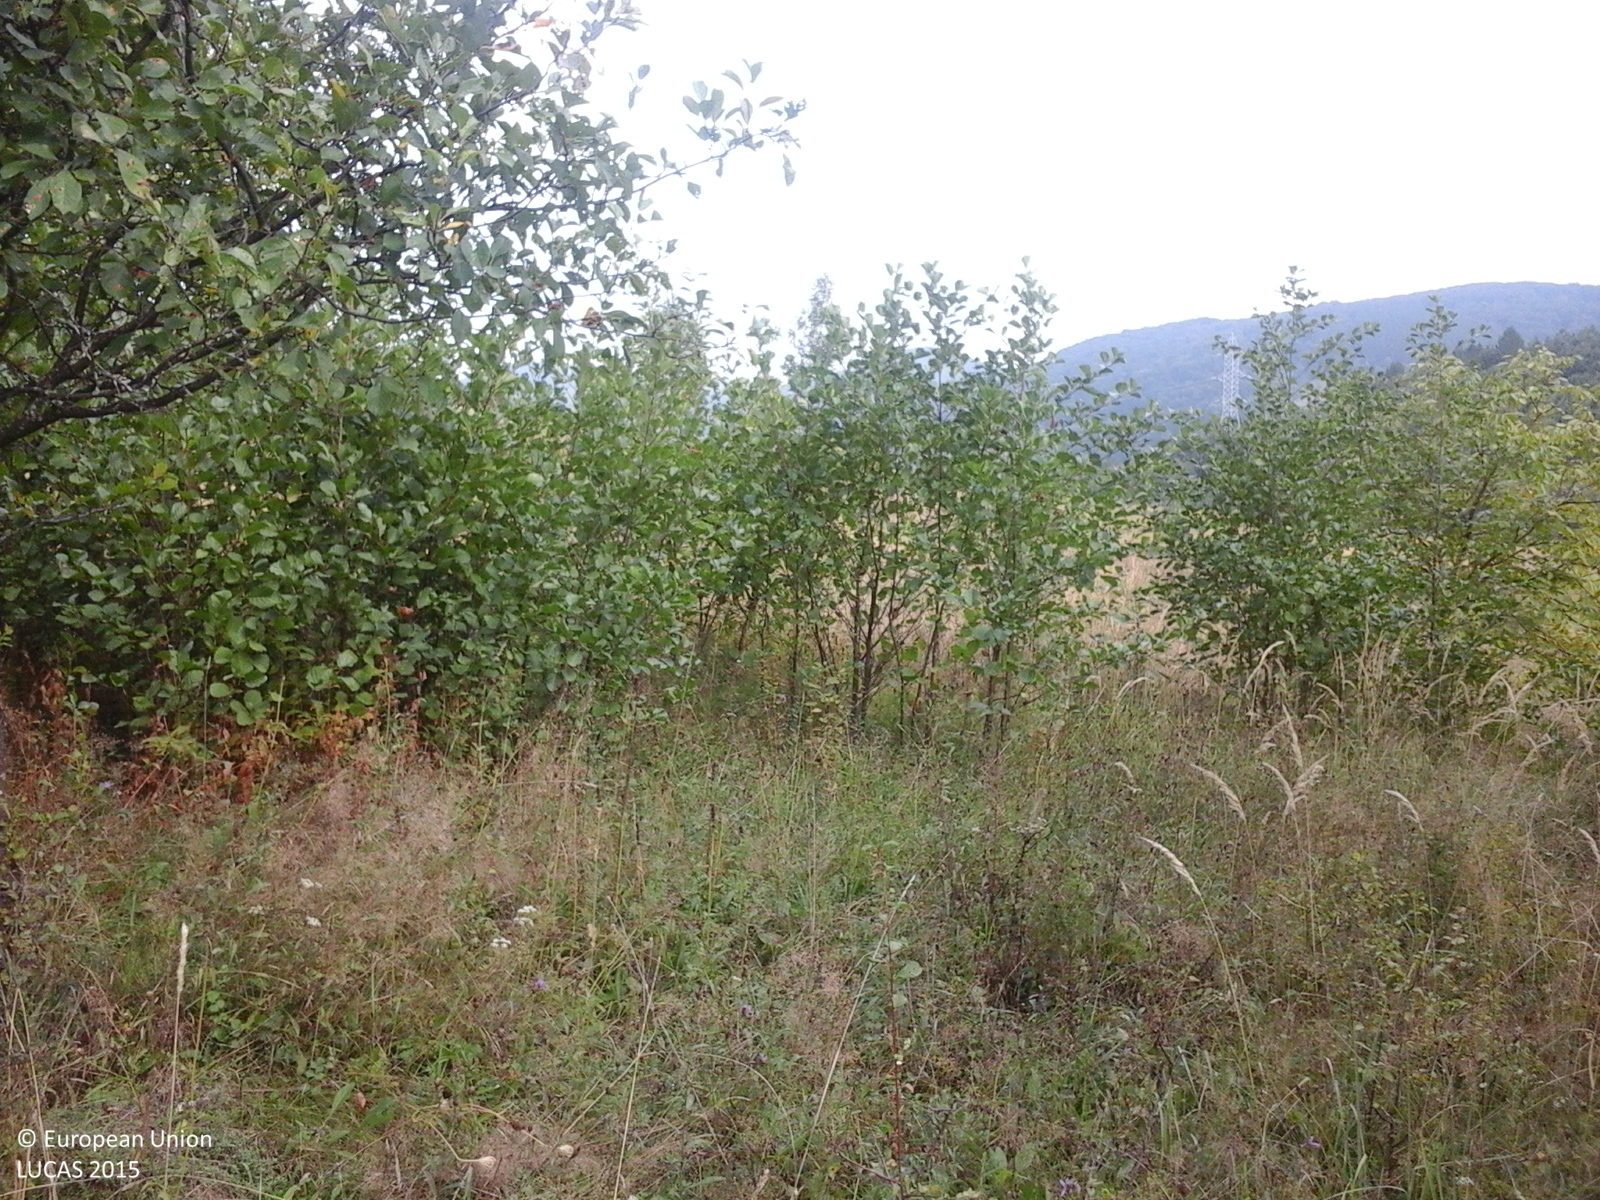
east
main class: Grassland
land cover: Grassland with sparse tree/shrub cover
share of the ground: > 75 %
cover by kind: herbaceous plants 85 %, shrubs 10 %, broadleaved forest trees 5 %
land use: Agriculture (excluding fallow land and kitchen gardens)
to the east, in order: Grassland with sparse tree/shrub cover; Grassland without tree/shrub cover; Shruby margins; Grassland without tree/shrub cover; Shruby margins; Grassland without tree/shrub cover; Shruby margins; Lucerne; Shruby margins; Clovers; Maize; Shruby margins; Grassland without tree/shrub cover; Broadleaved woodland
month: September
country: RO
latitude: 46.9296
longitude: 22.6250
